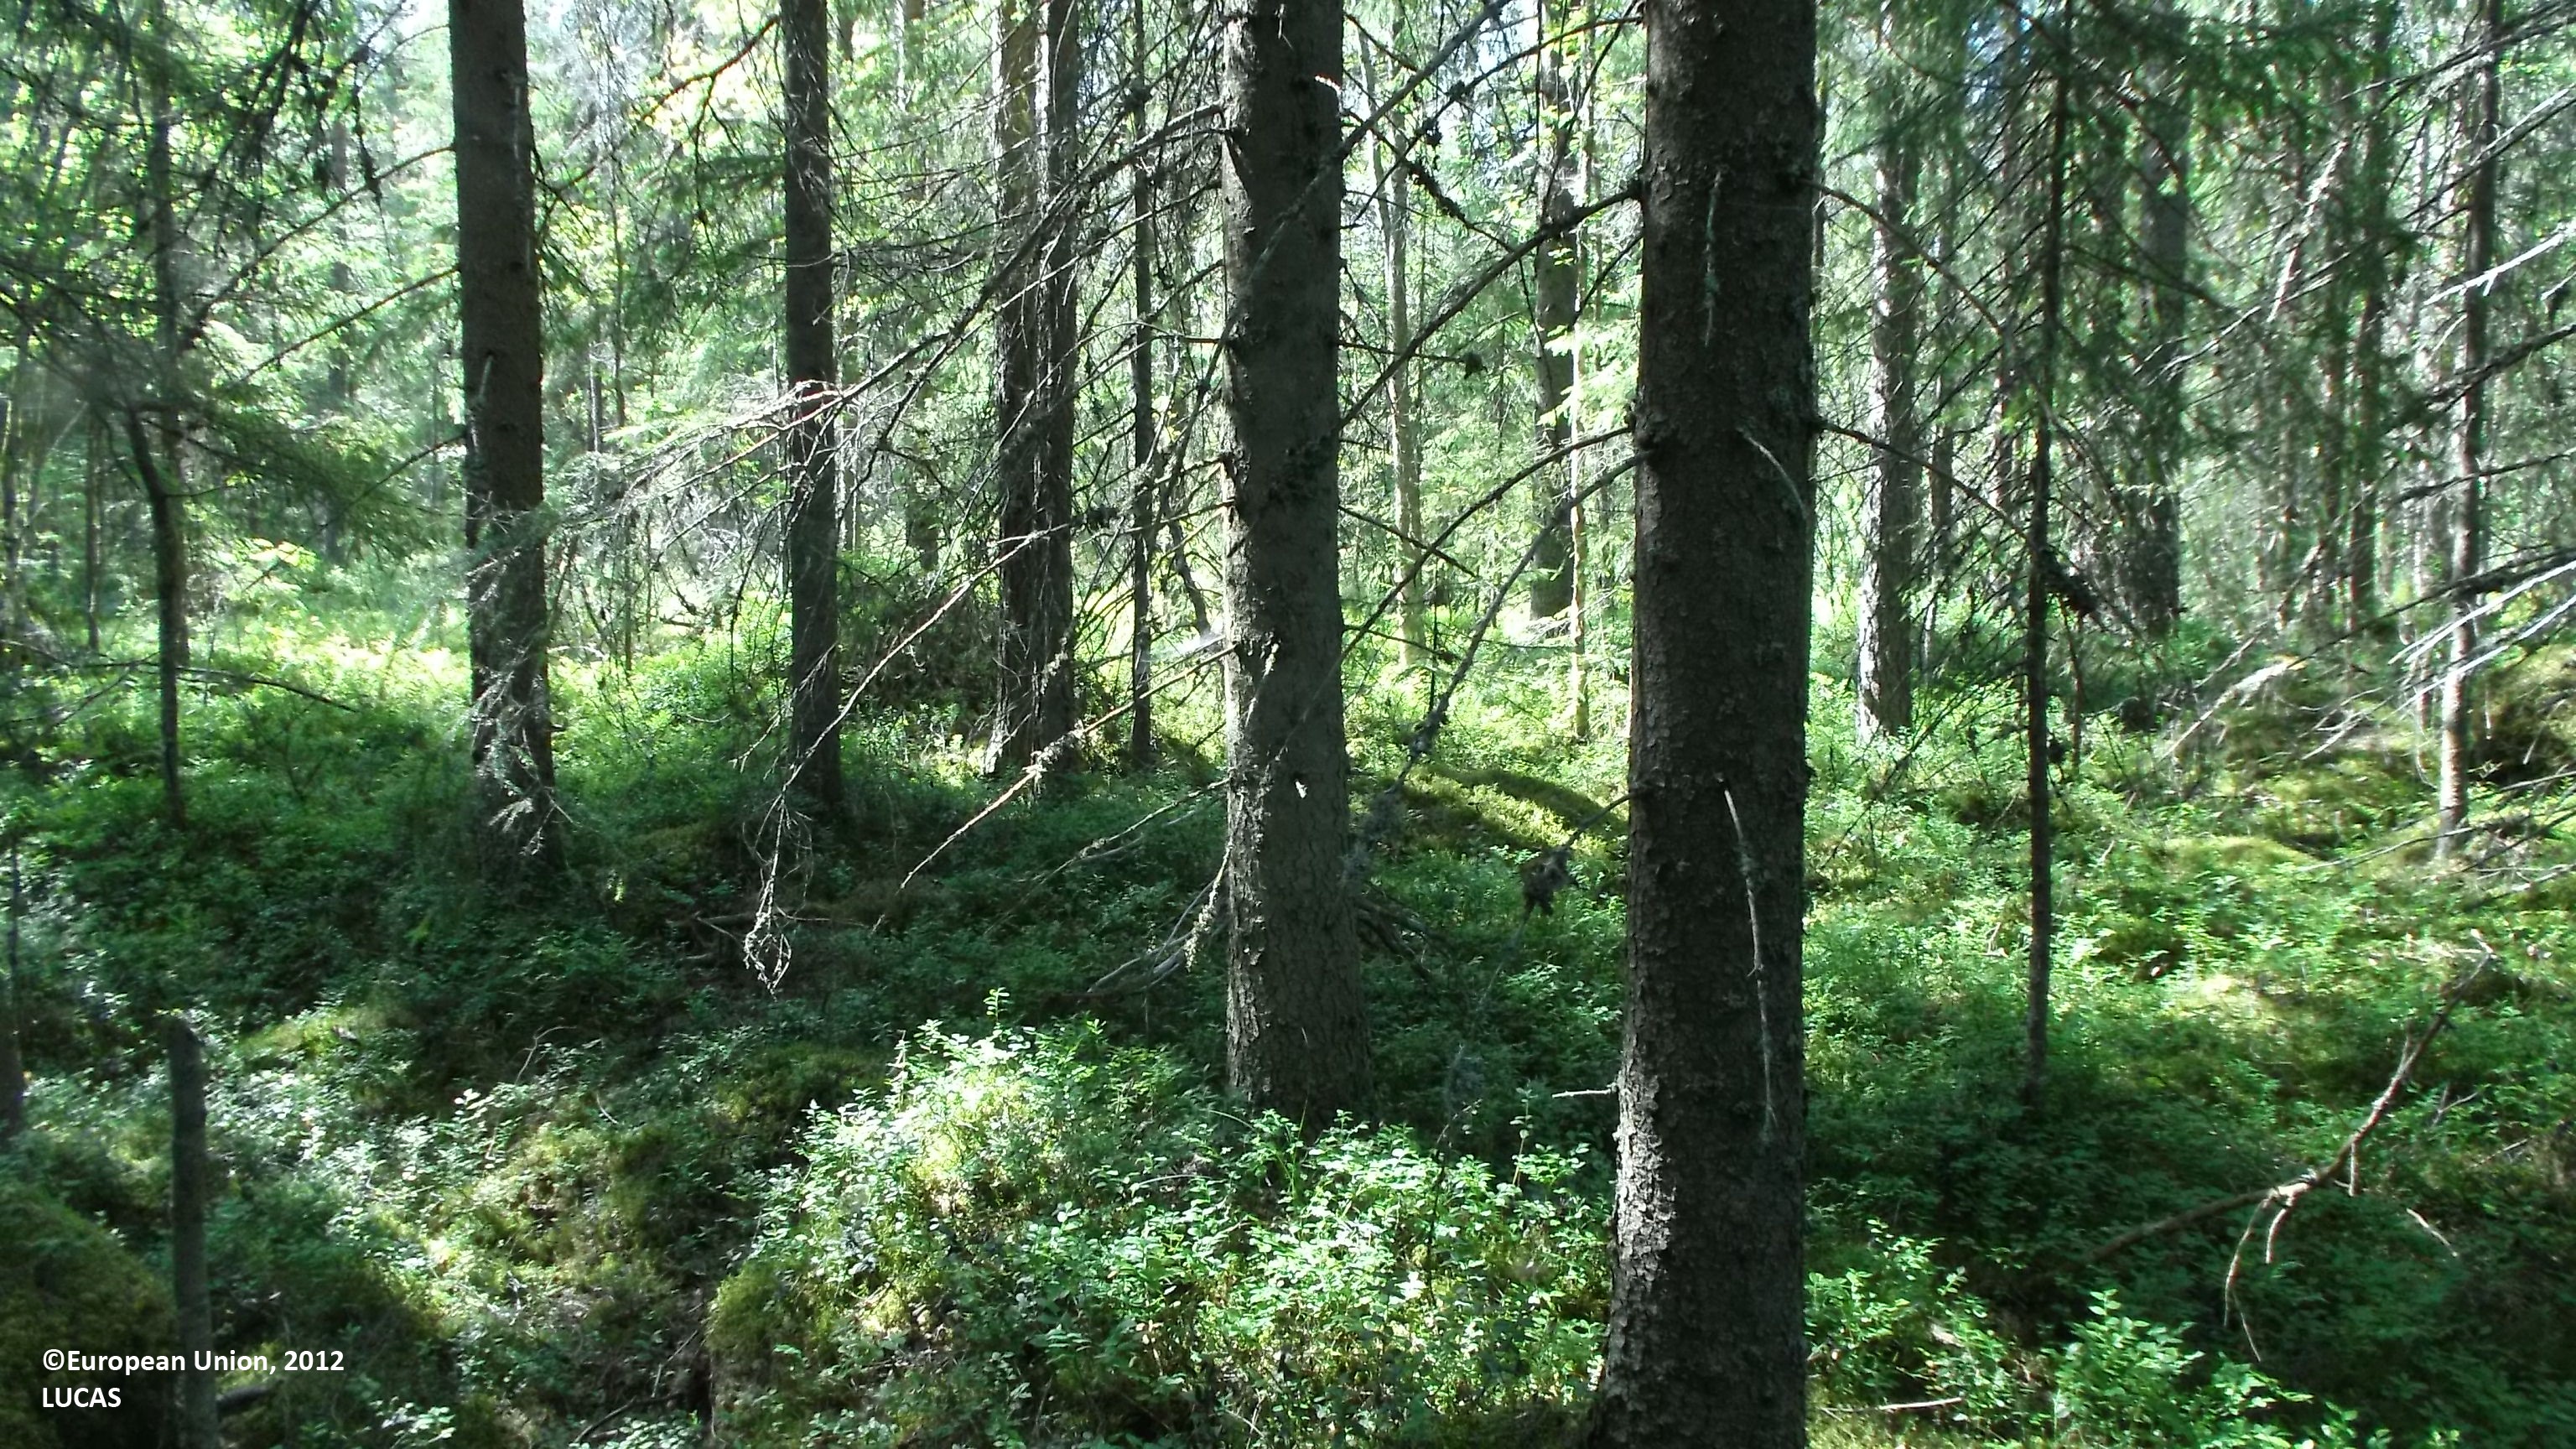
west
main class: Woodland
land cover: Spruce dominated coniferous woodland
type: boreal forest
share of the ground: > 75 %
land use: Forestry
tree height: > 5 m
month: July
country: FI
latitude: 63.6642
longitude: 23.9891
